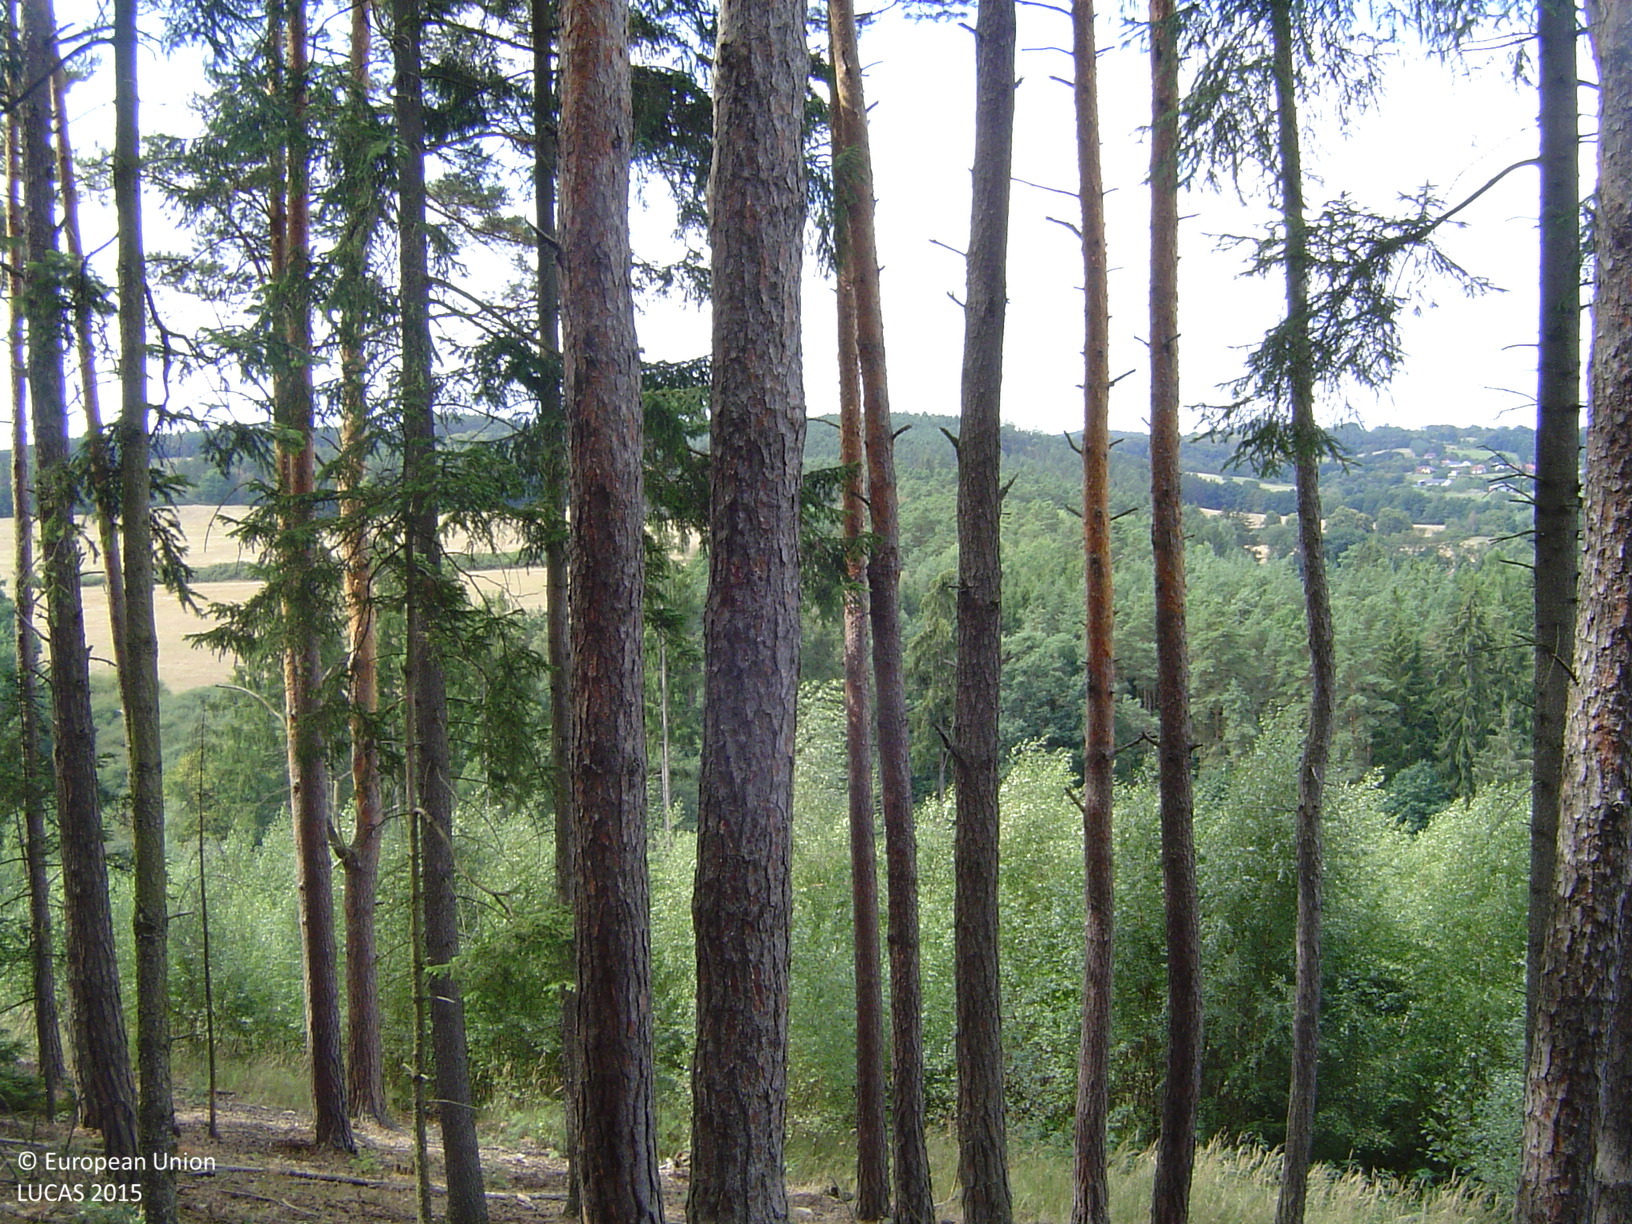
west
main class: Woodland
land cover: Pine dominated mixed woodland
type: hemiboreal forest and nemoral coniferous forest and mixed broadleaved-coniferous forest
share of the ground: > 75 %
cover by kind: coniferous forest trees 65 %, broadleaved forest trees 25 %, shrubs 10 %
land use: Forestry
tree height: > 5 m
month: August
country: CZ
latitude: 49.7930
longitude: 14.4050
